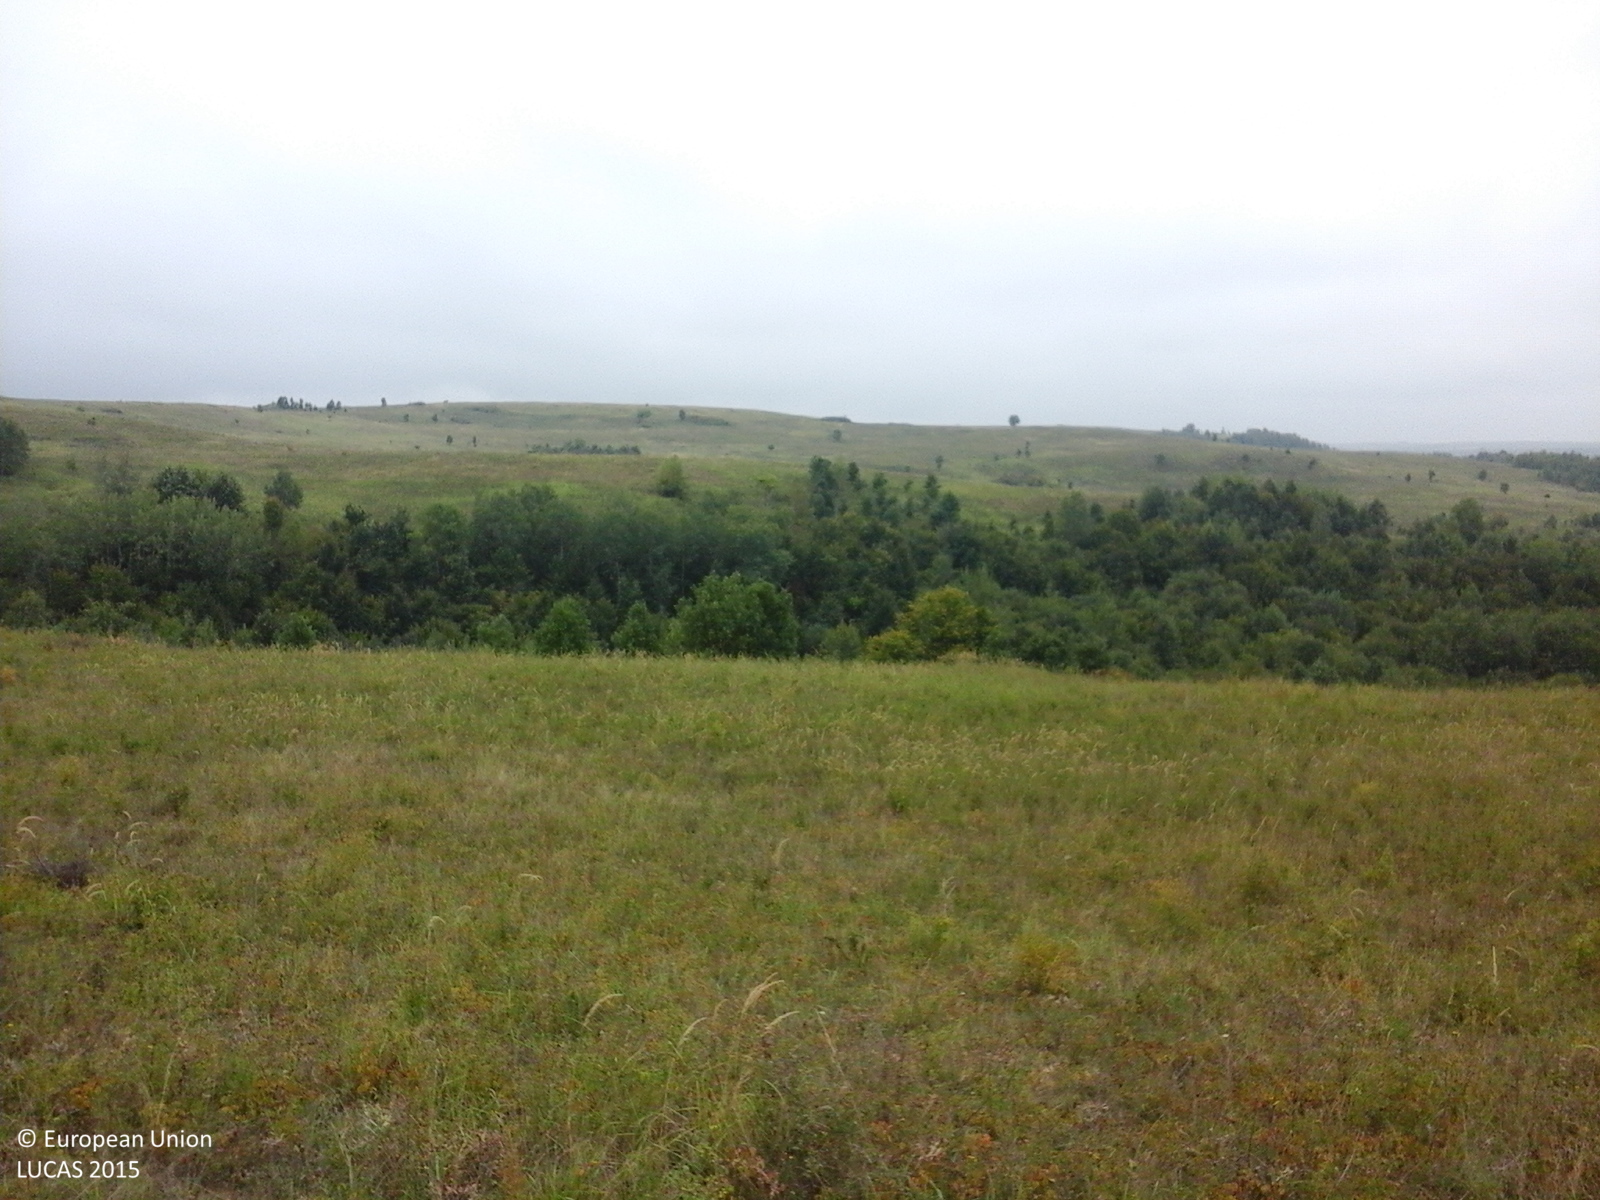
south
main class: Grassland
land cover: Grassland without tree/shrub cover
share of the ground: > 75 %
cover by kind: herbaceous plants 100 %
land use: Agriculture (excluding fallow land and kitchen gardens)
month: September
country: RO
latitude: 45.8927
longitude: 21.9875
